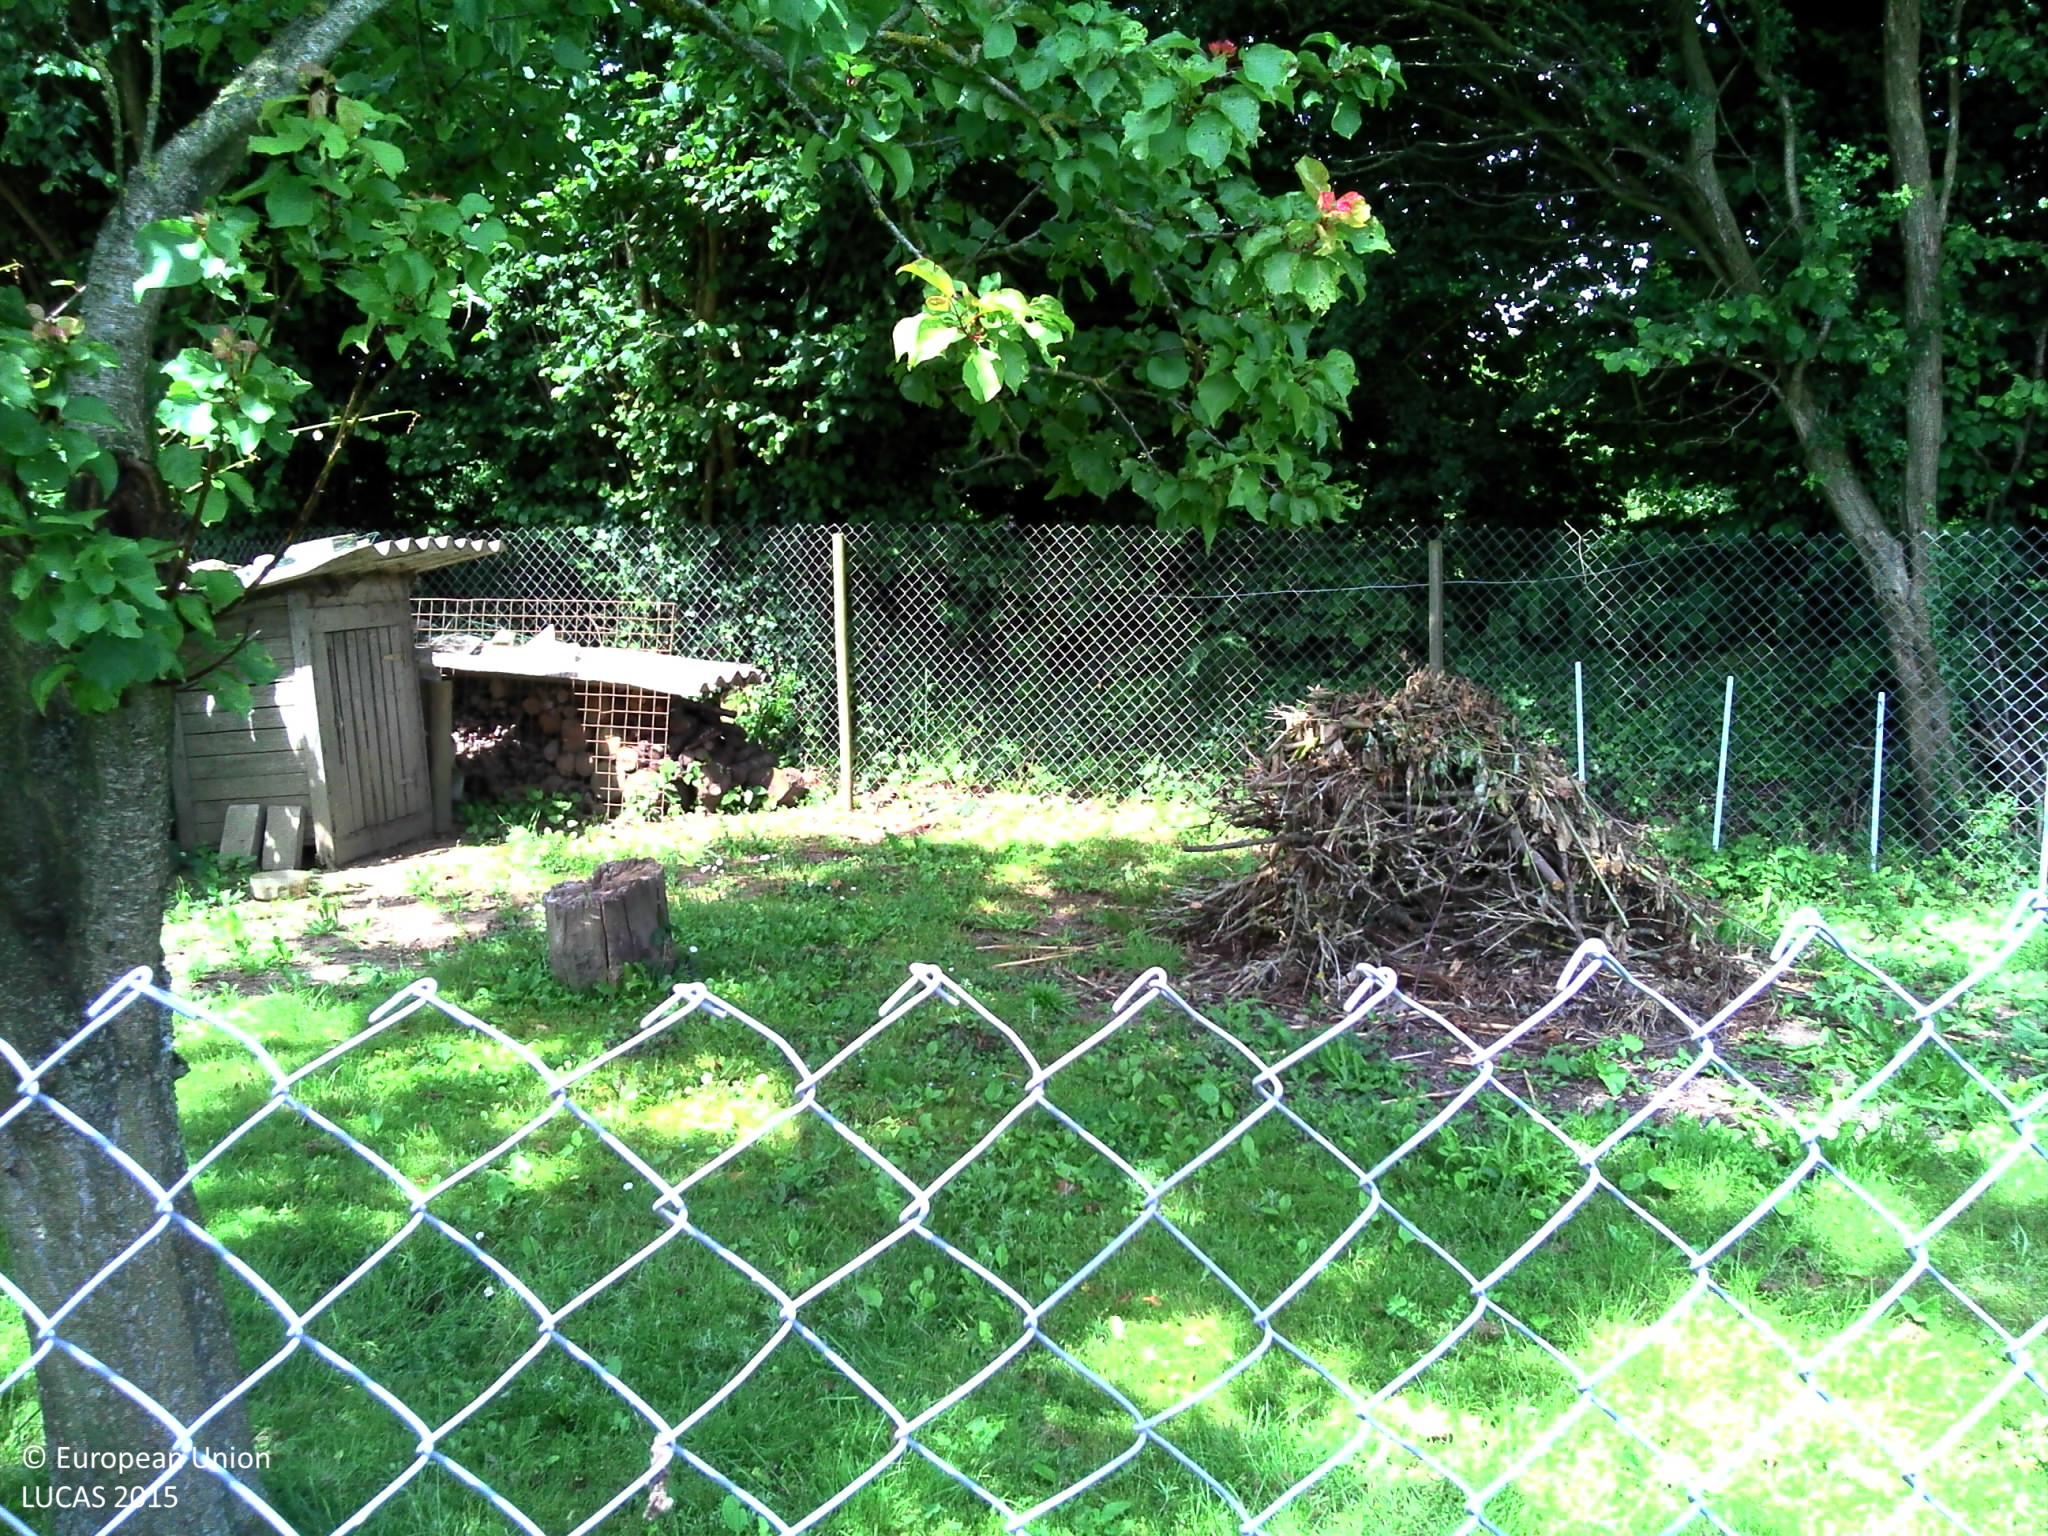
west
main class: Grassland
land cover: Grassland with sparse tree/shrub cover
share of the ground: > 75 %
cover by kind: herbaceous plants 95 %, broadleaved forest trees 5 %
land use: Residential
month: June
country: FR
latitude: 49.2163
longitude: -1.3454
